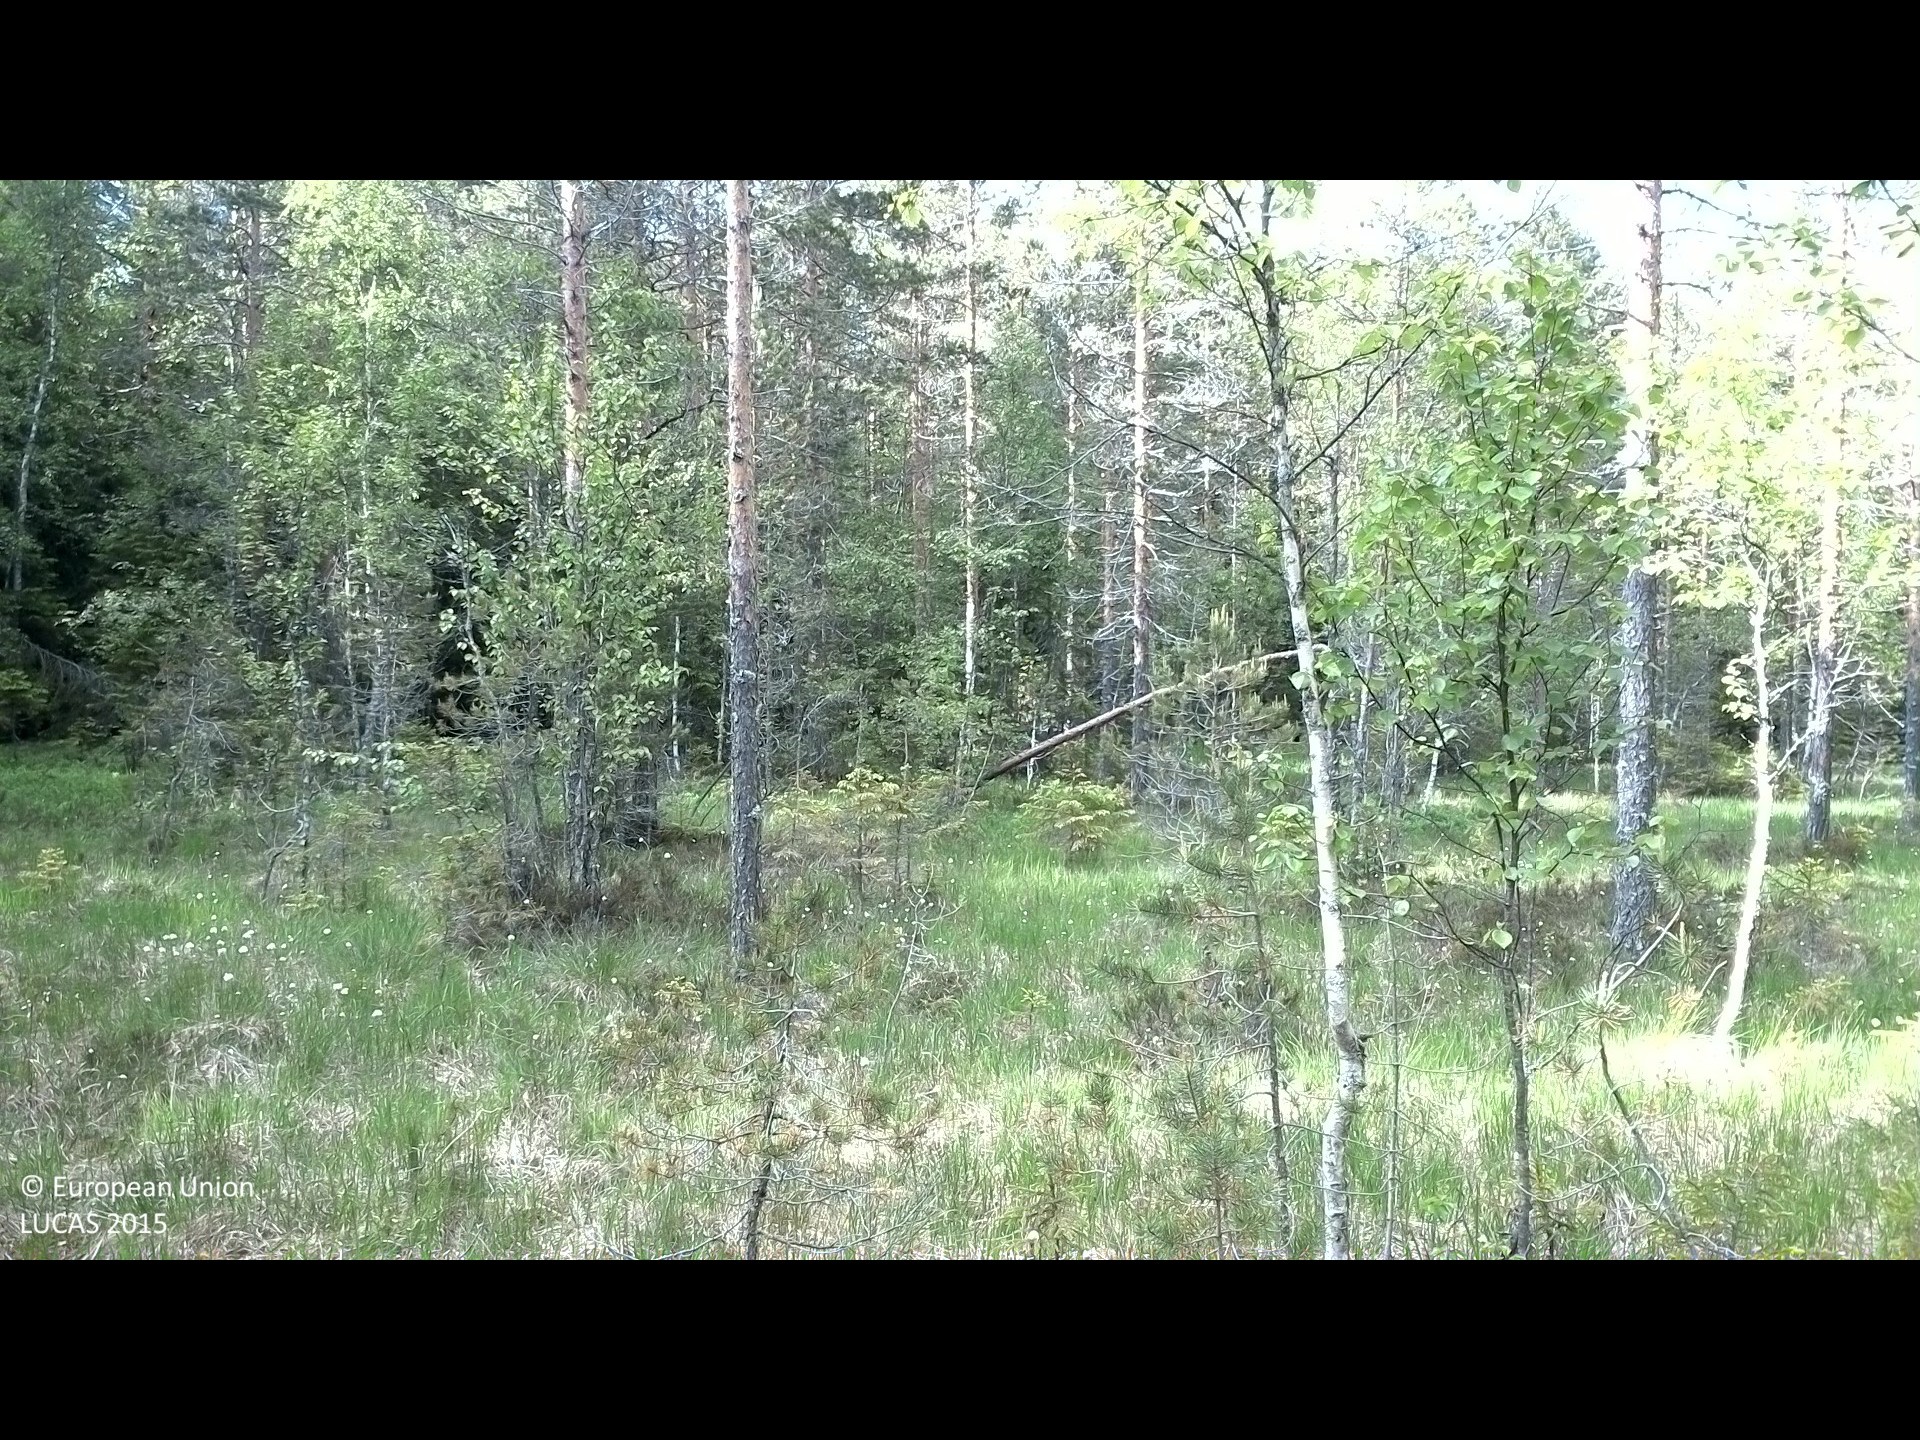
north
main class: Woodland
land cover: Pine dominated mixed woodland
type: boreal forest
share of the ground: 10 - 25 %
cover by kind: herbaceous plants 40 %, lichens and mosses 30 %, coniferous forest trees 15 %, broadleaved forest trees 10 %, shrubs 5 %
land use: Semi-natural and natural areas not in use
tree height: > 5 m
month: June
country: SE
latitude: 62.0079
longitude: 16.7619
